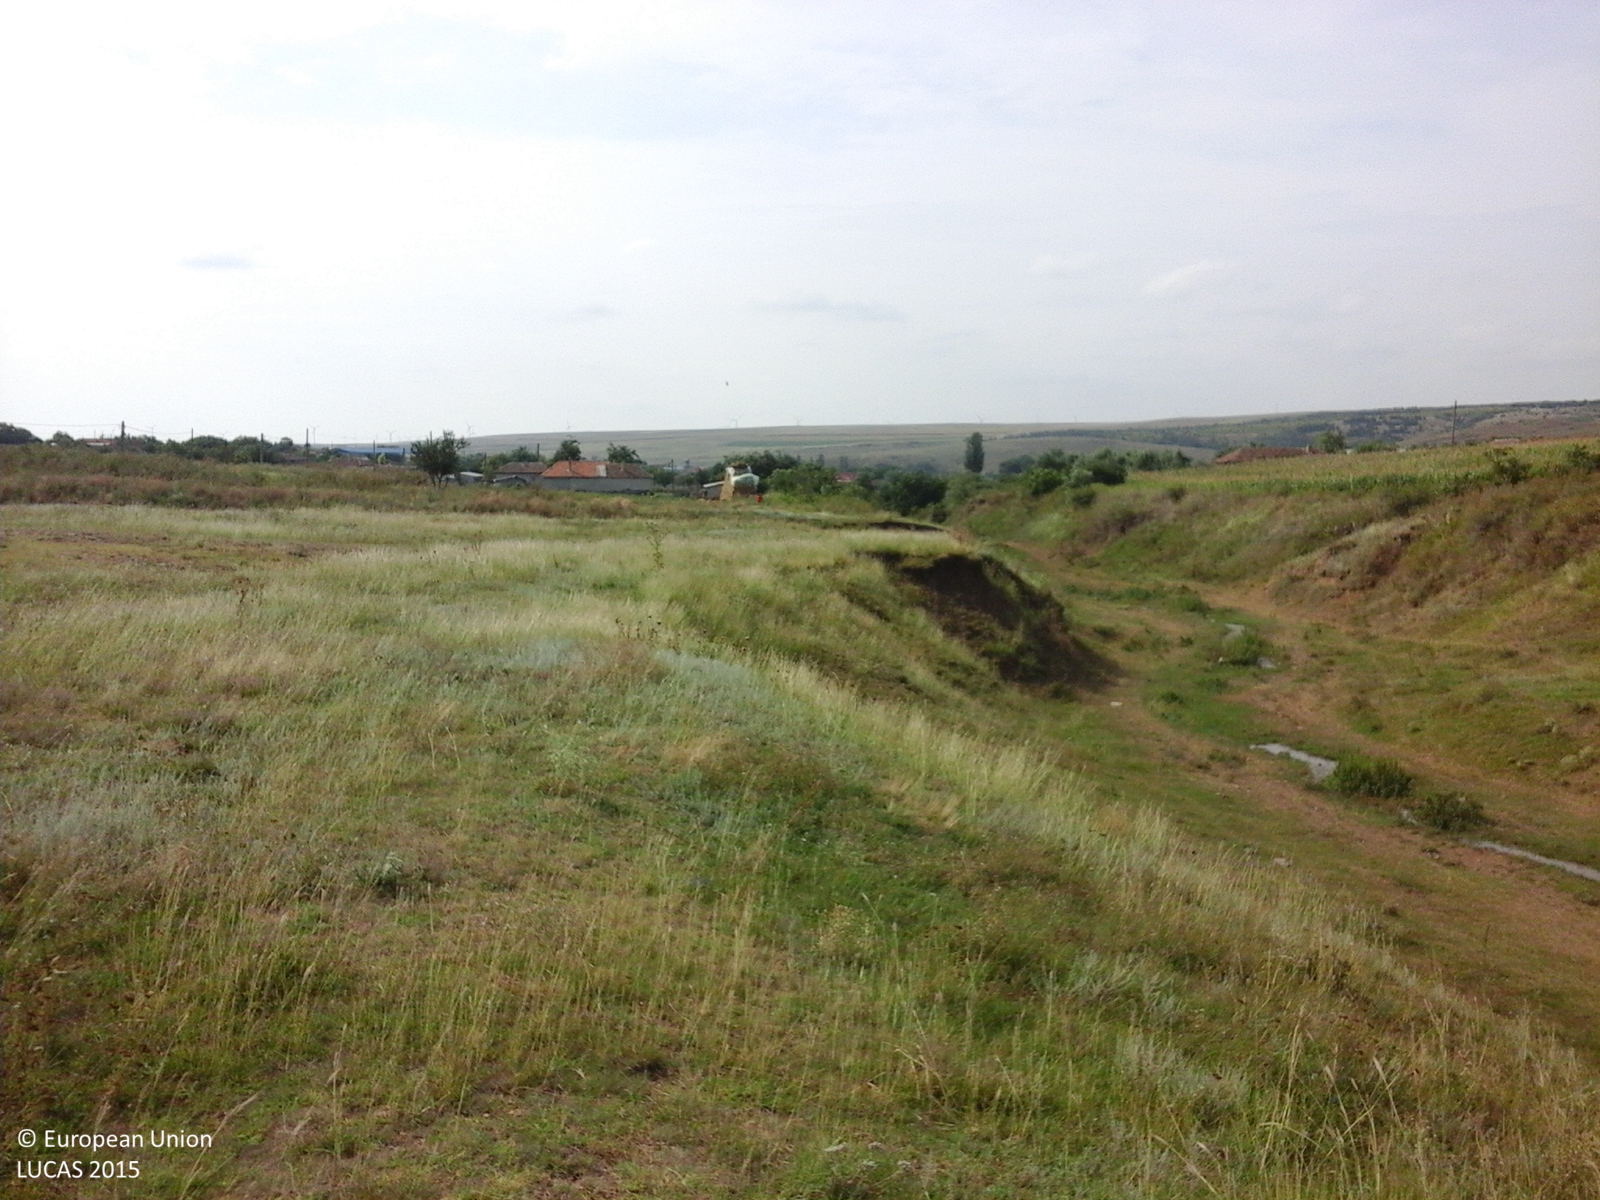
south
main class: Grassland
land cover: Grassland without tree/shrub cover
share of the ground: > 75 %
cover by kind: herbaceous plants 100 %
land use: Agriculture (excluding fallow land and kitchen gardens)
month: August
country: RO
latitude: 44.7240
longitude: 28.5741
